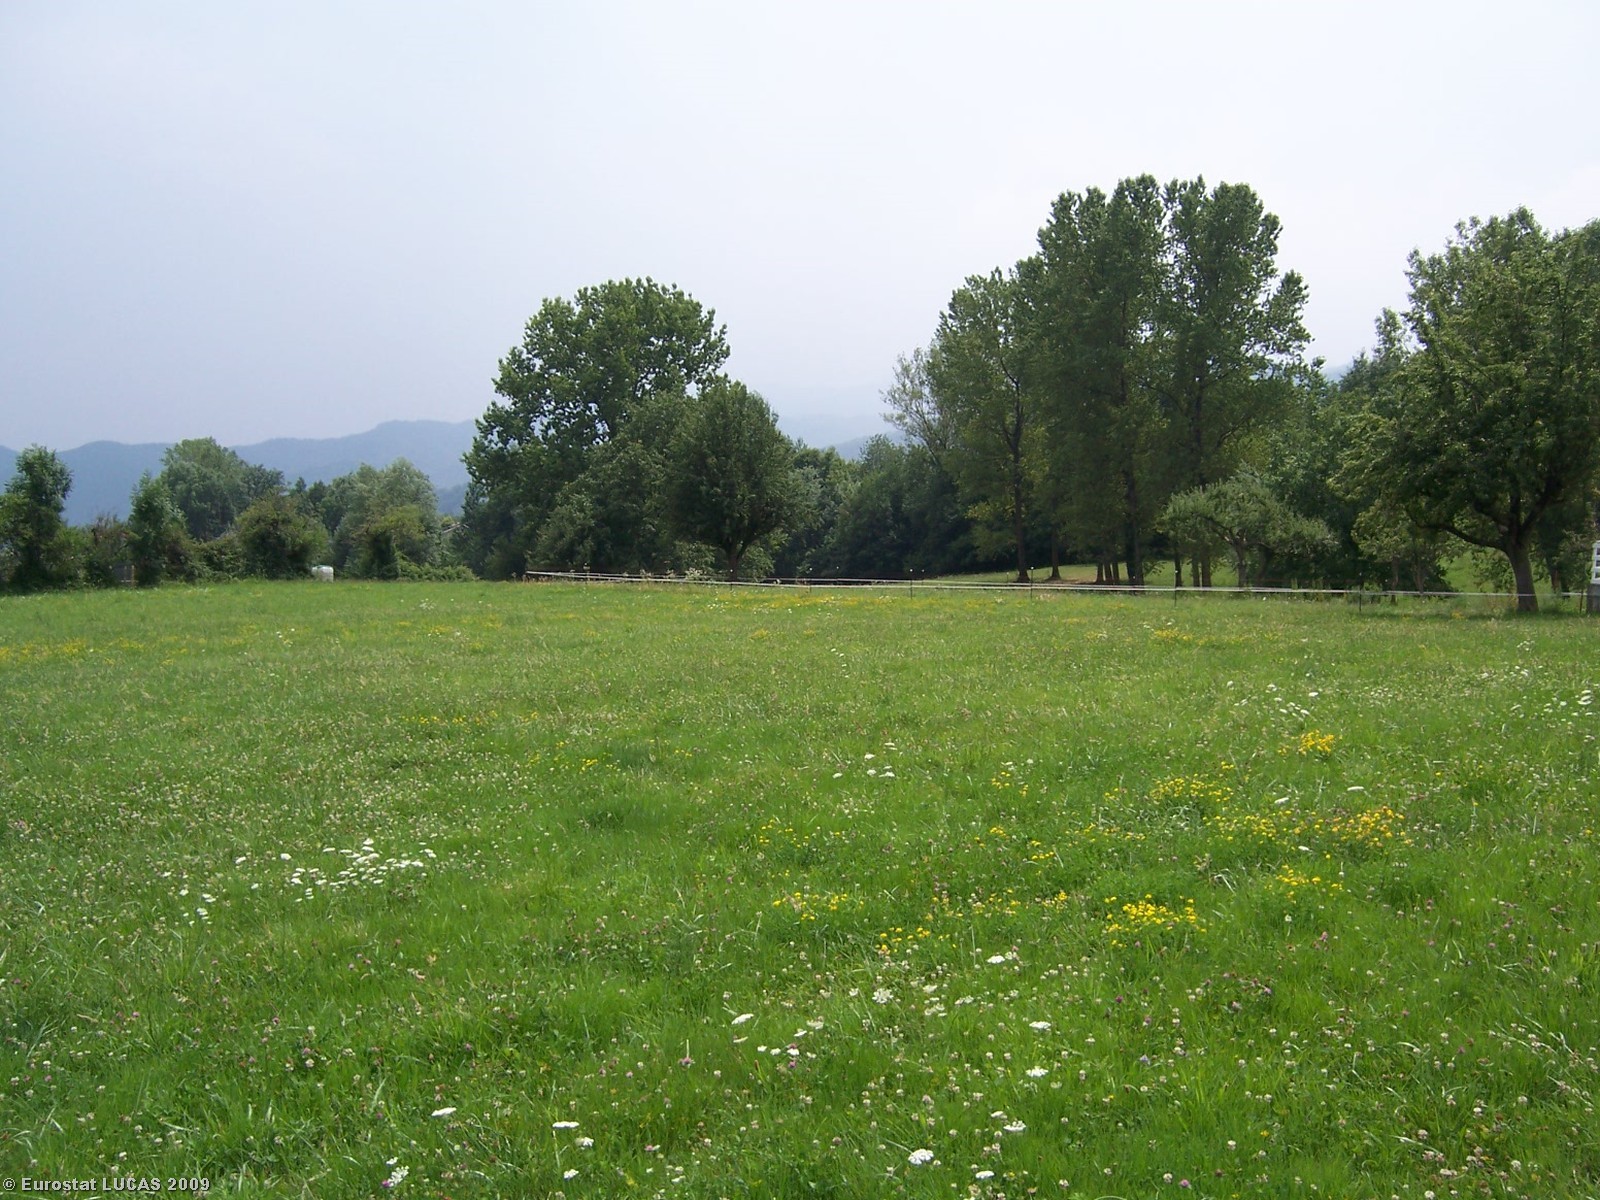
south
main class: Grassland
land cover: Grassland without tree/shrub cover
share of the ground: > 75 %
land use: Agriculture (excluding fallow land and kitchen gardens)
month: July
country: IT
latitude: 45.0558
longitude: 7.3252
